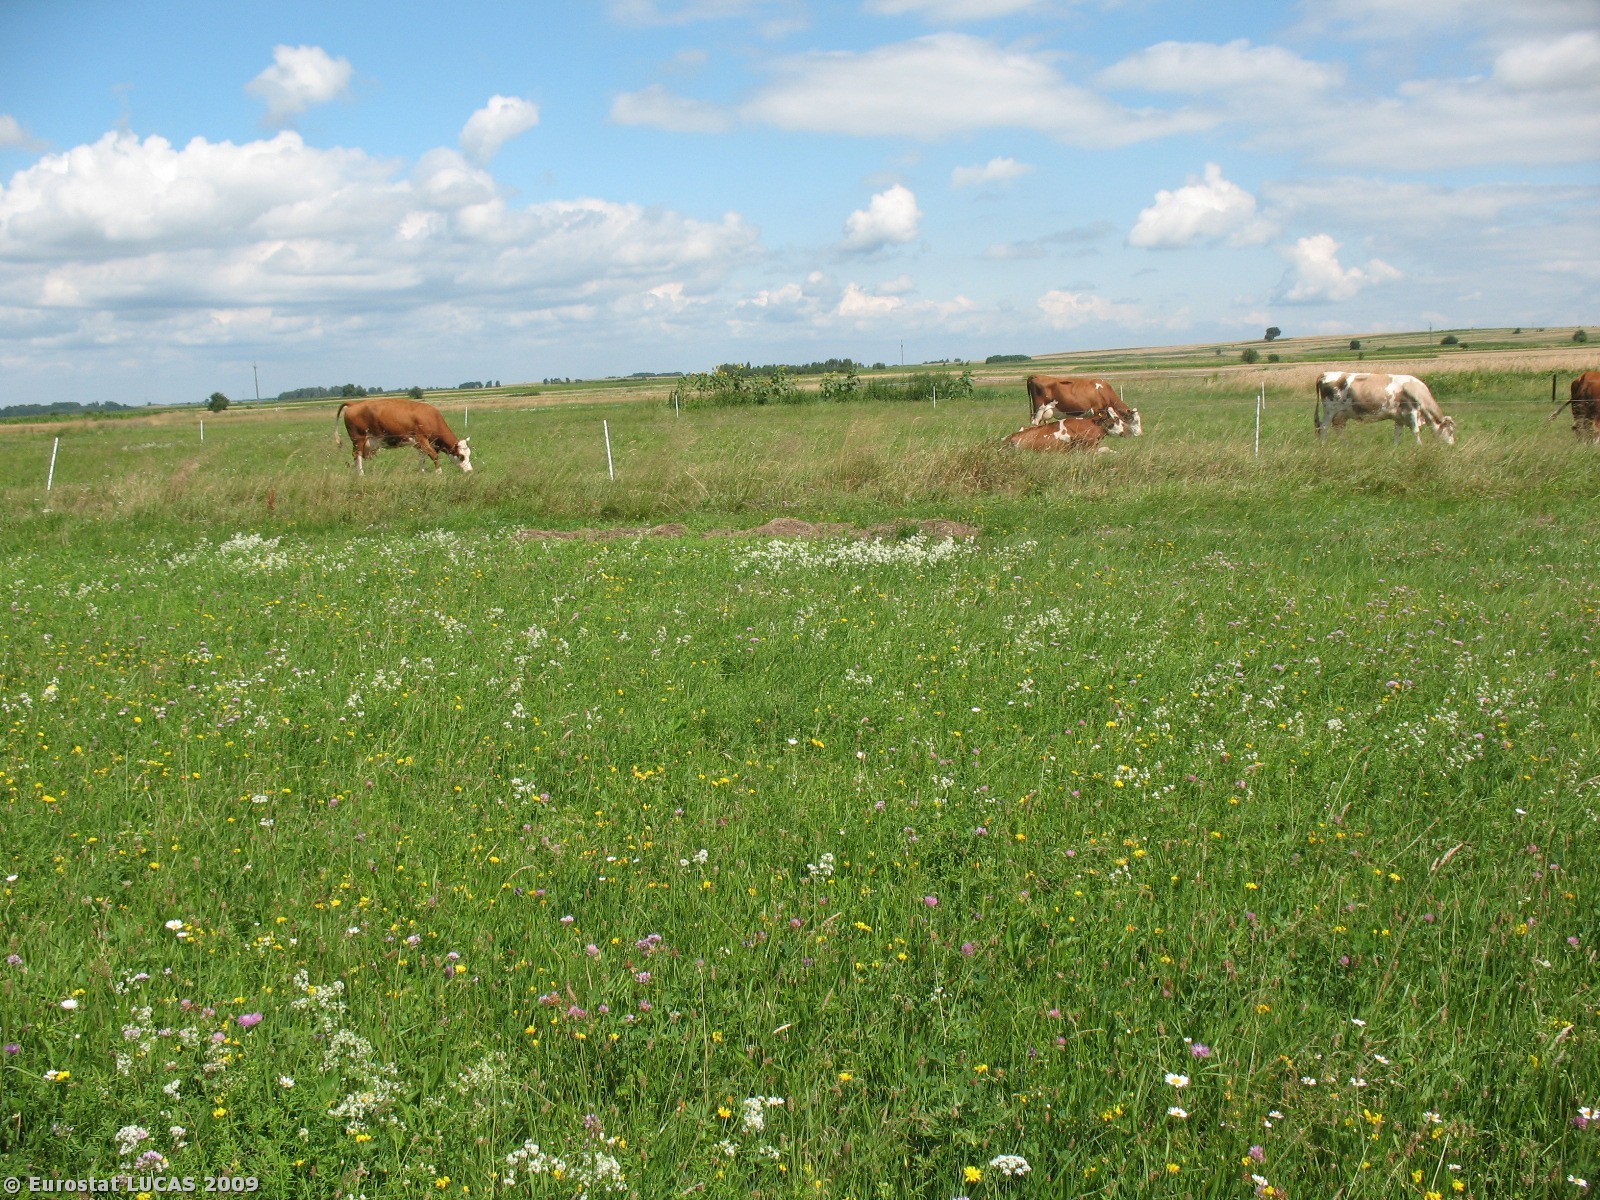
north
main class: Grassland
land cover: Grassland without tree/shrub cover
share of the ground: > 75 %
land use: Agriculture (excluding fallow land and kitchen gardens)
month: July
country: PL
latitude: 50.3165
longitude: 22.1233
